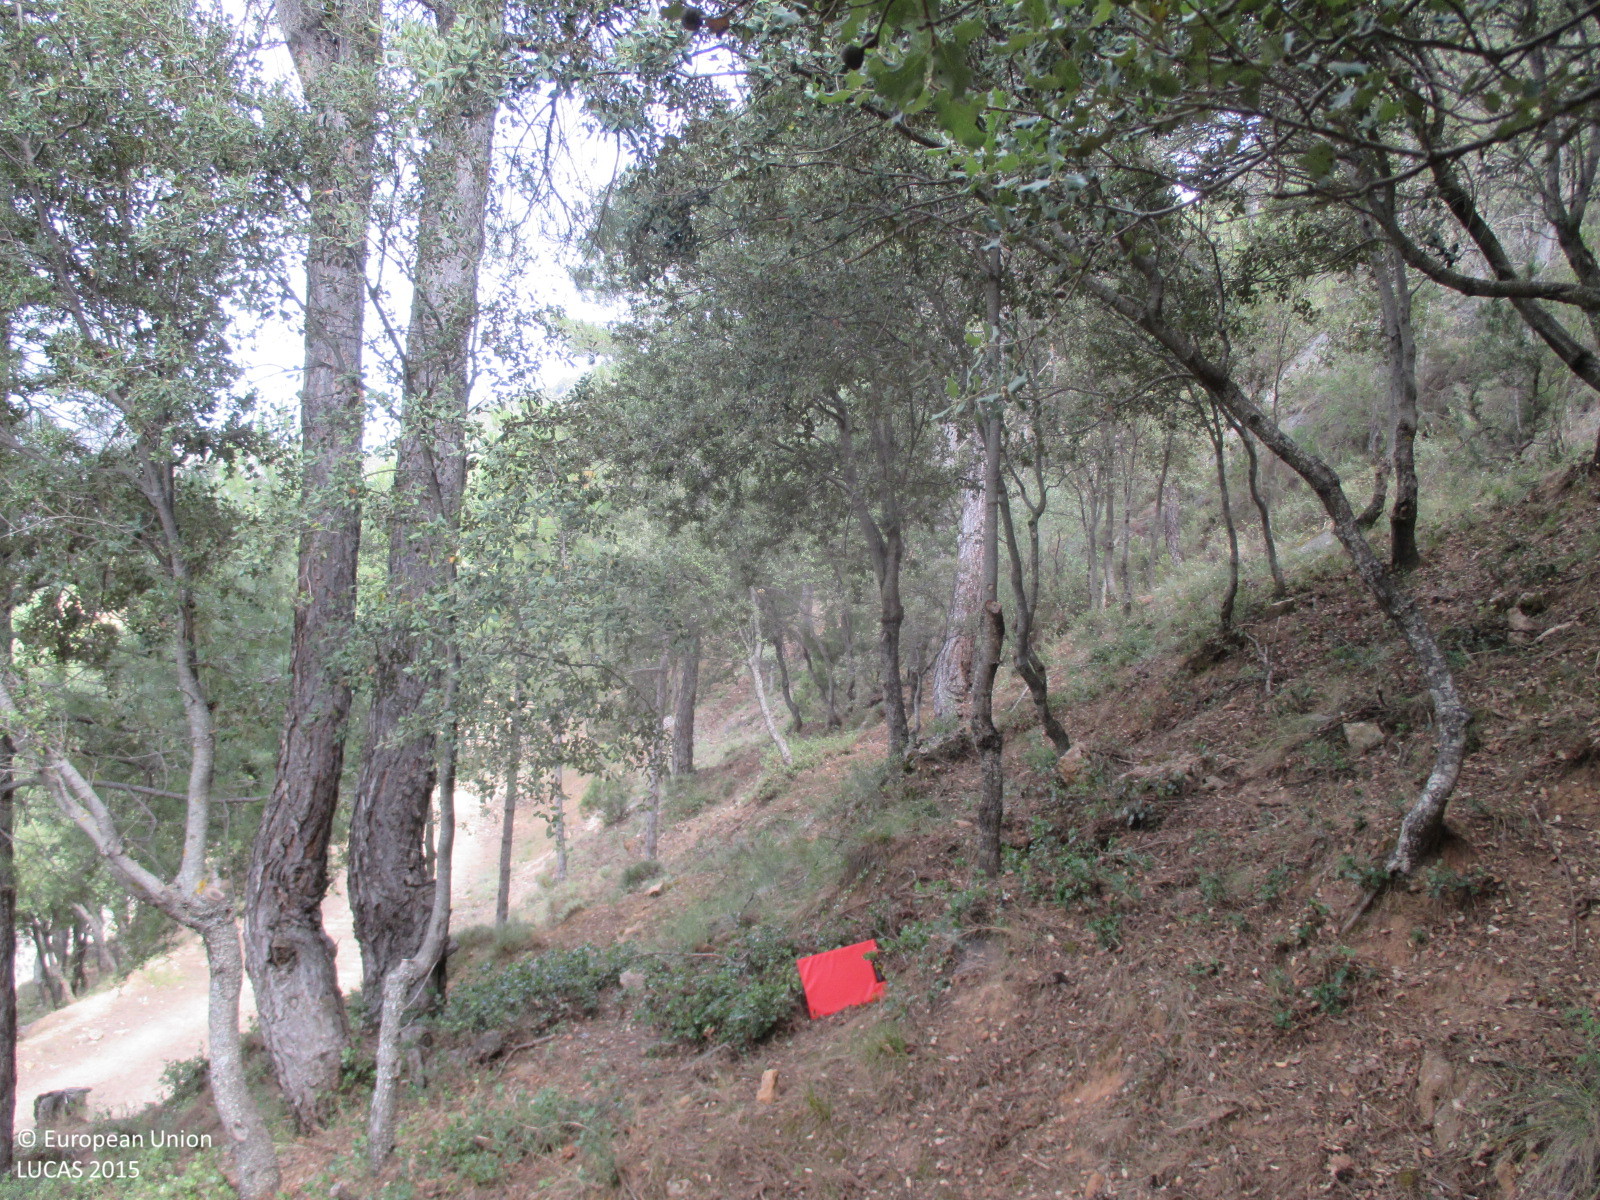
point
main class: Woodland
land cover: Broadleaved woodland
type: broadleaved evergreen forest
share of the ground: > 75 %
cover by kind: broadleaved forest trees 95 %, coniferous forest trees 5 %
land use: Forestry
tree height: > 5 m
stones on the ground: < 10 %
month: July
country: ES
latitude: 38.1870
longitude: -2.4735
